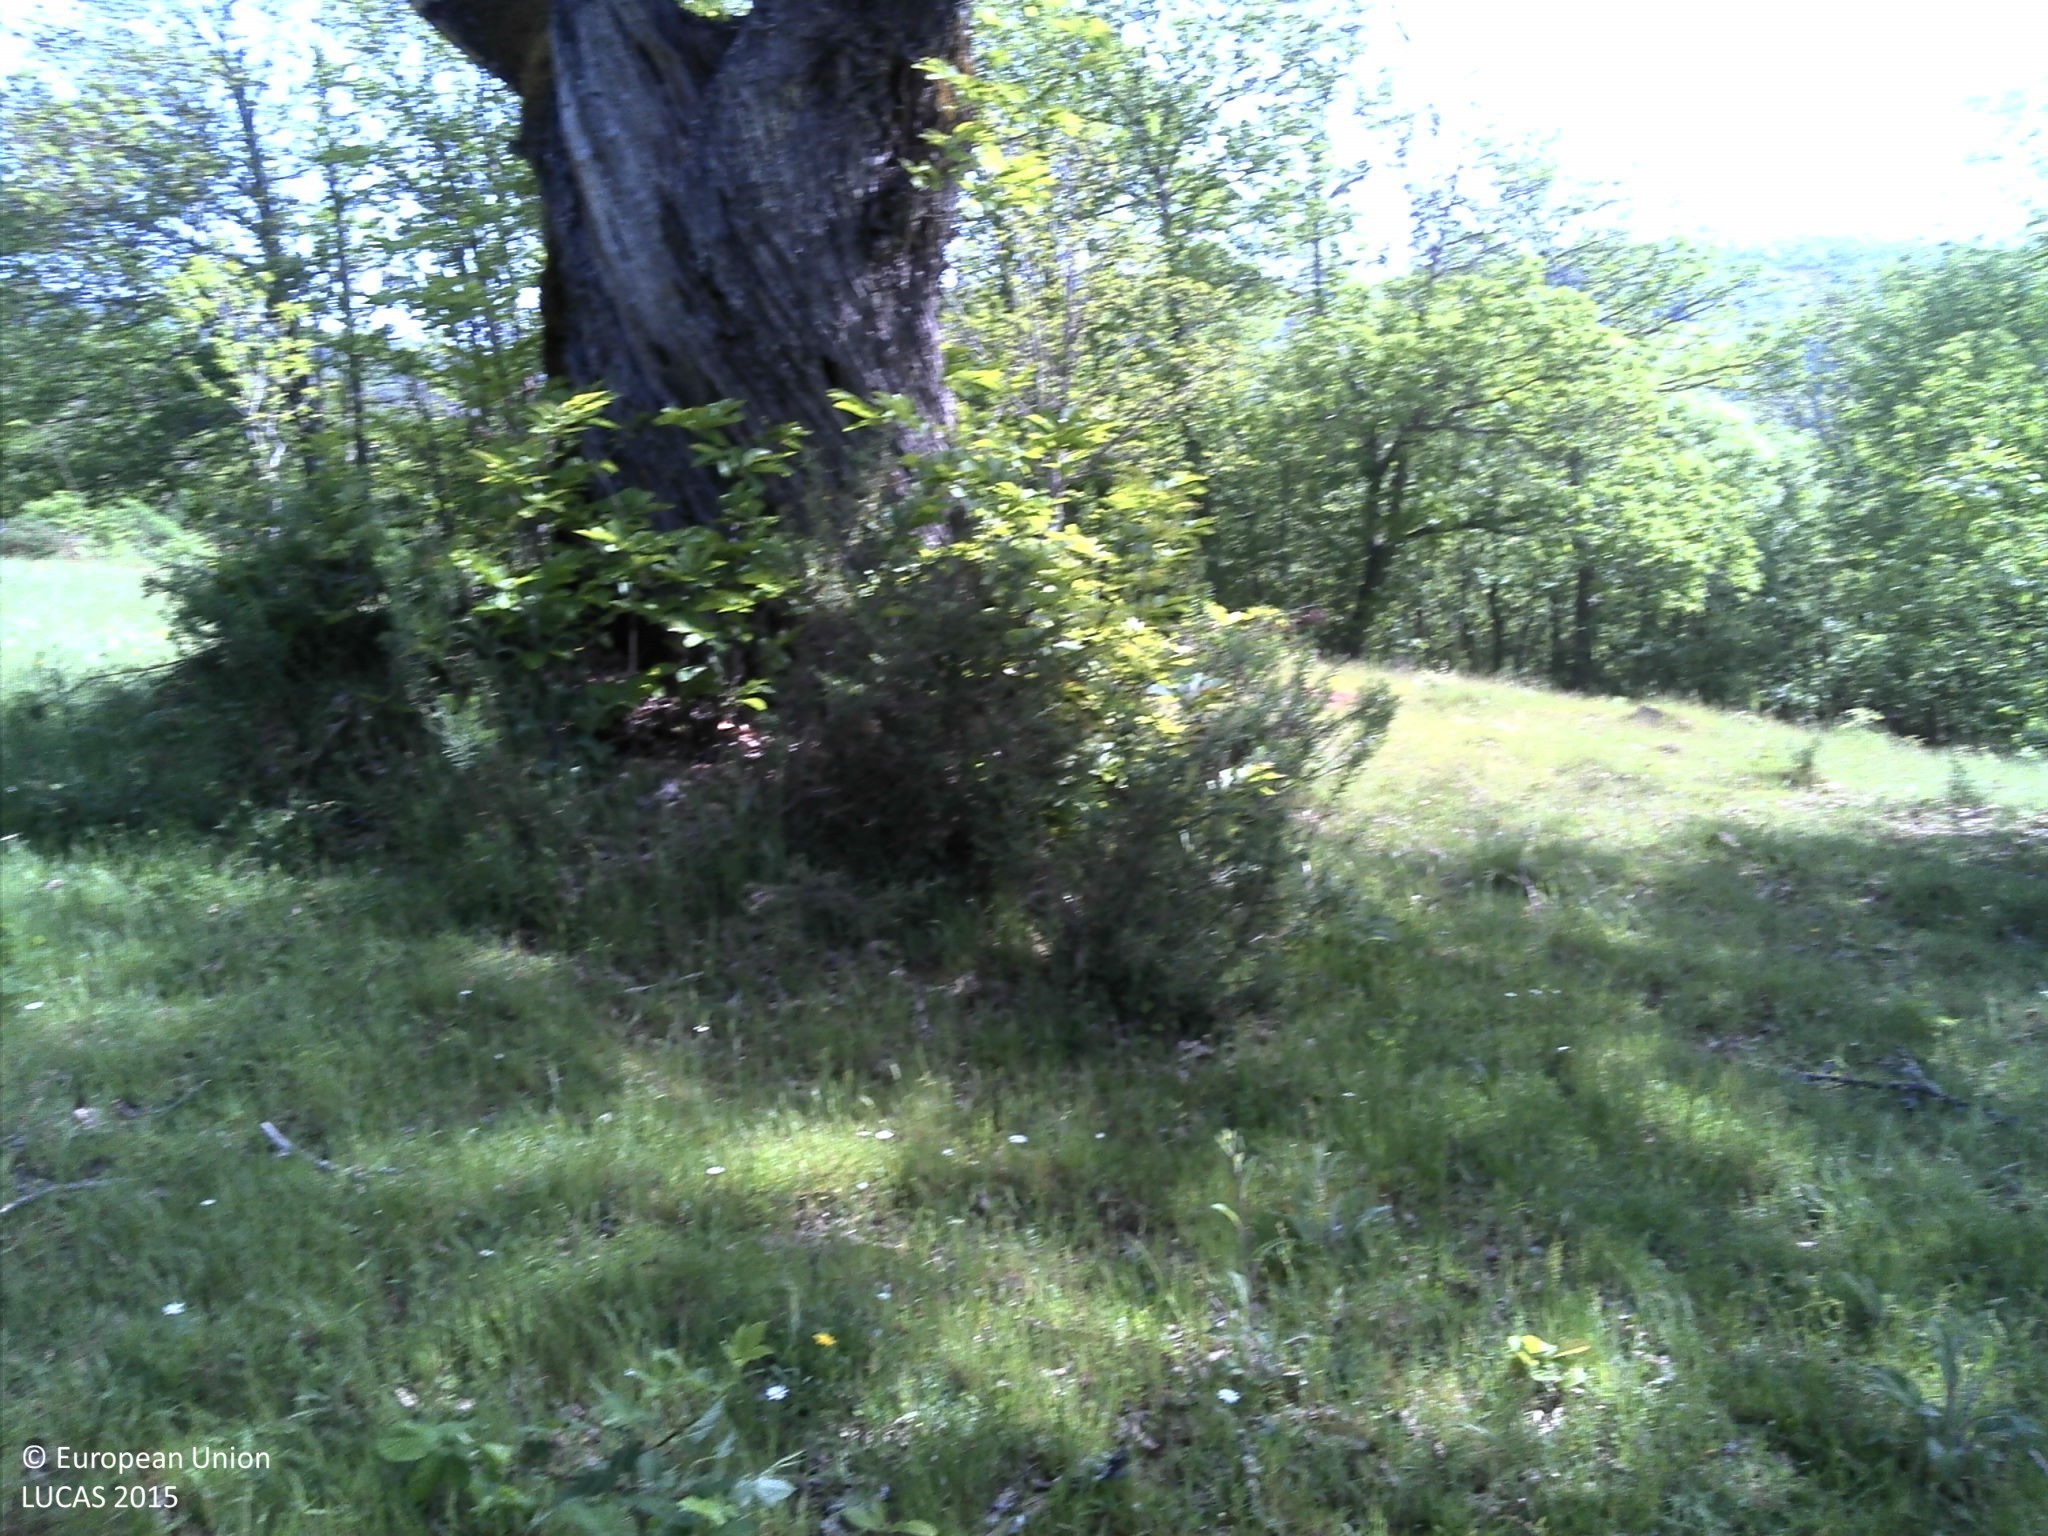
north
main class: Cropland
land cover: Nuts trees
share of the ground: 25 - 50 %
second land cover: Grassland without tree/shrub cover
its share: 25 - 50 %
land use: Agriculture (excluding fallow land and kitchen gardens)
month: May
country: PT
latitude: 41.8460
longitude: -7.0176
